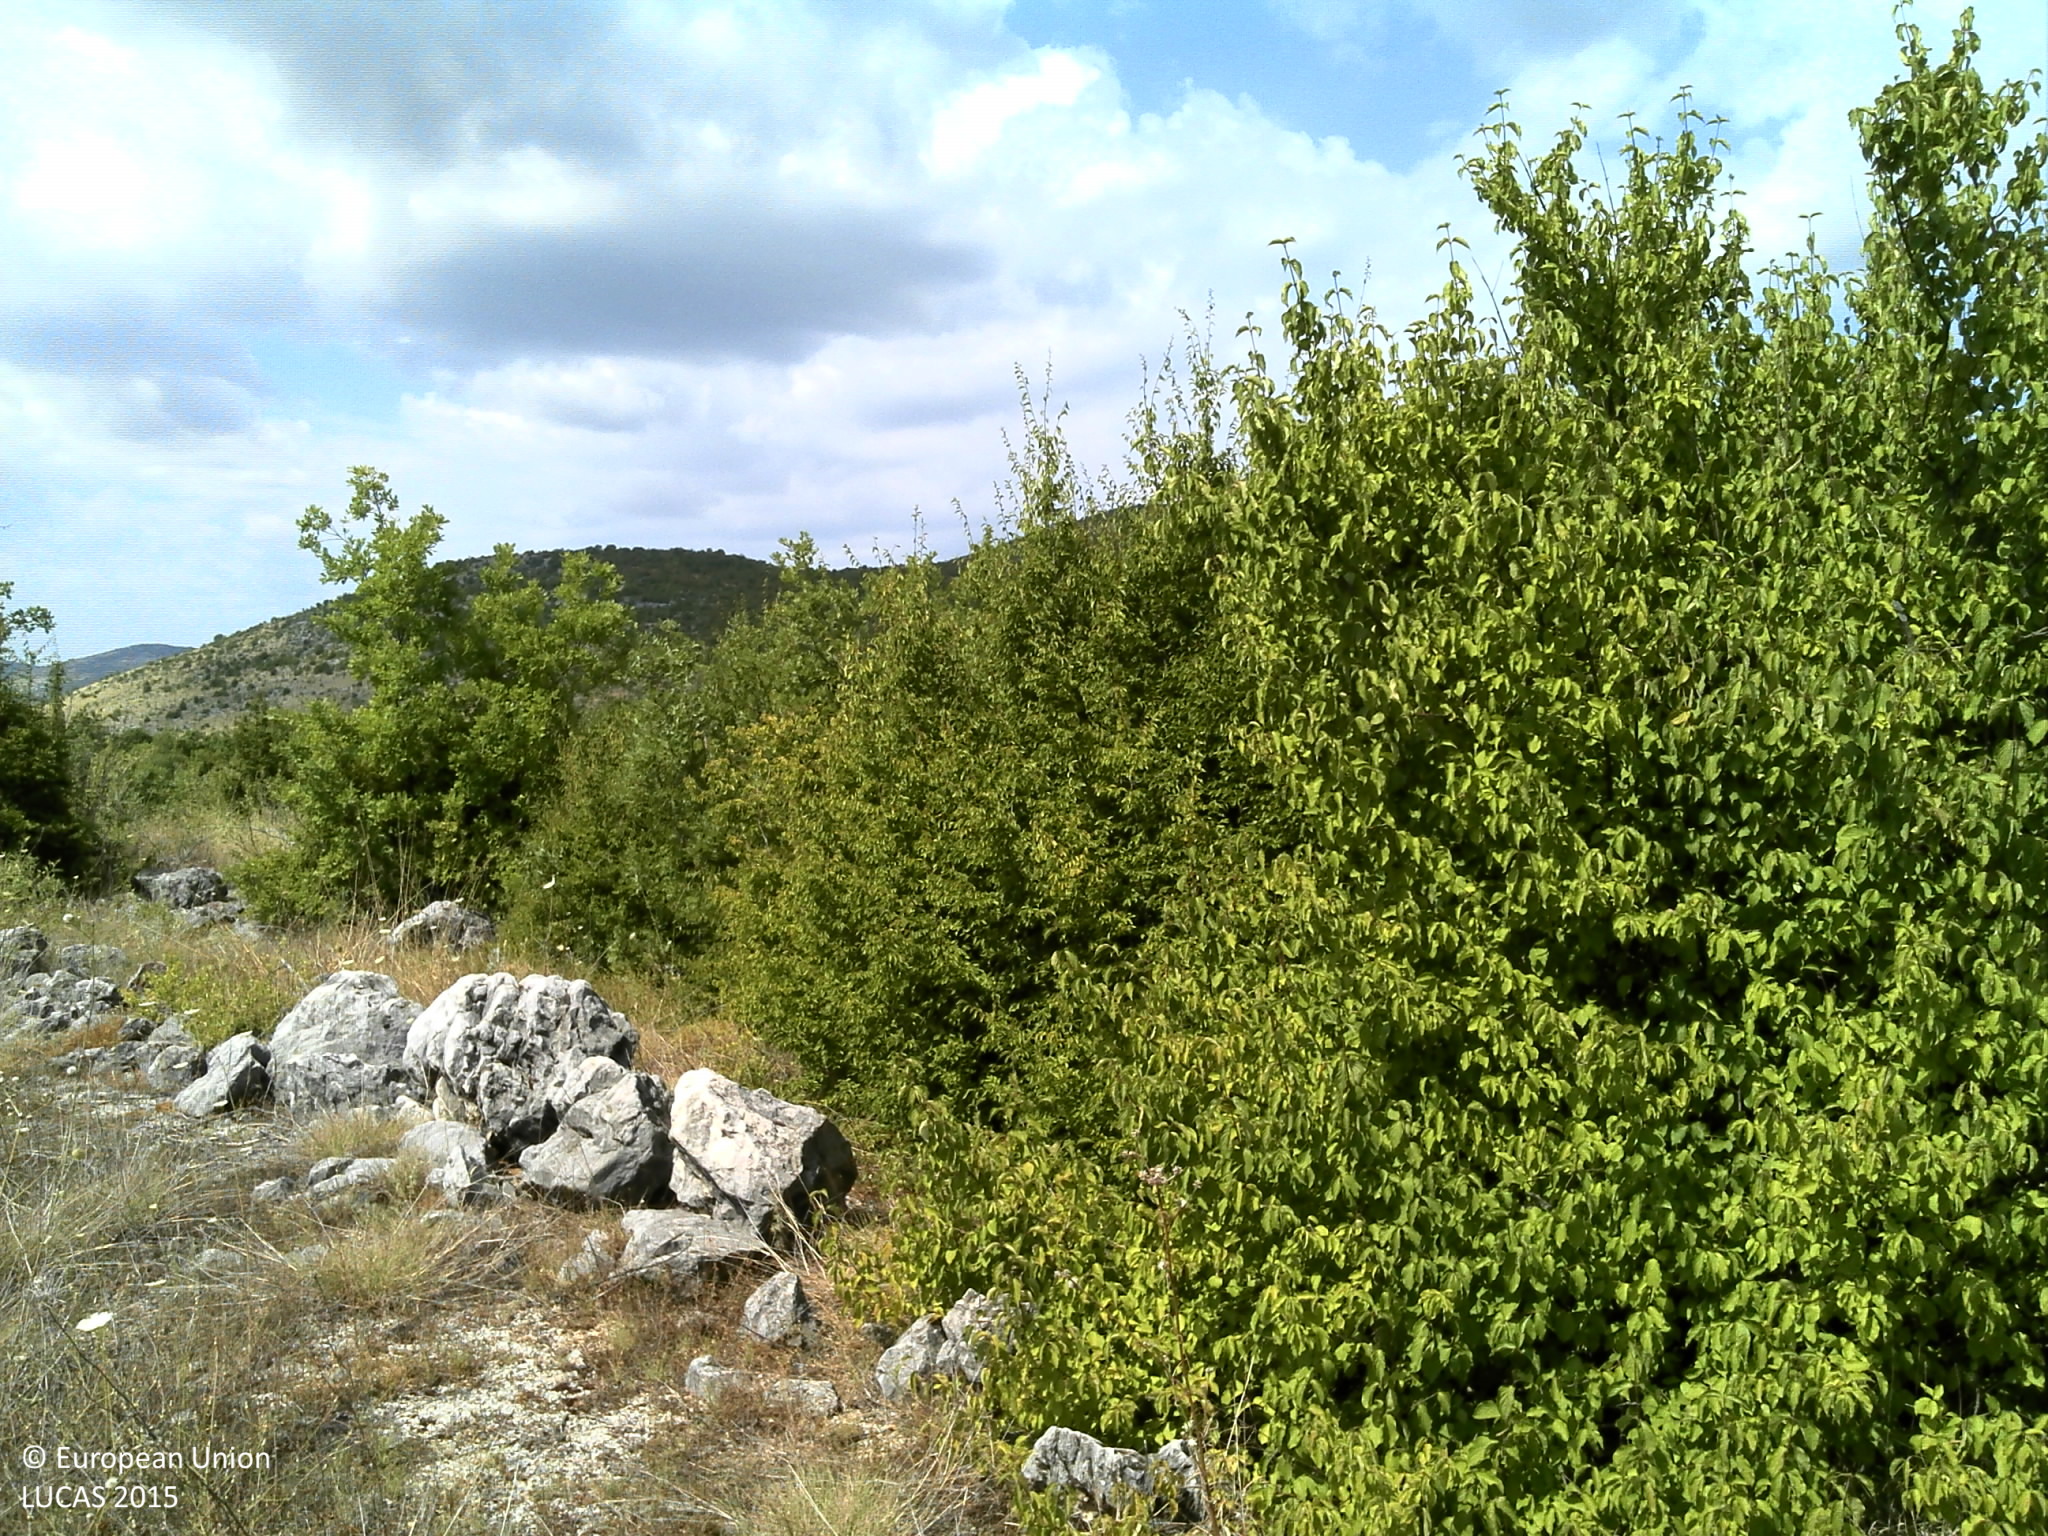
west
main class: Shrubland
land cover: Shrubland with sparse tree cover
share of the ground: 25 - 50 %
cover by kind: herbaceous plants 50 %, shrubs 20 %, unconsolidated bare surface 15 %, consolidated bare surface 10 %, broadleaved forest trees 5 %
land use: Semi-natural and natural areas not in use
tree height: < 5 m
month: July
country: HR
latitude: 43.6974
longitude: 16.1579
